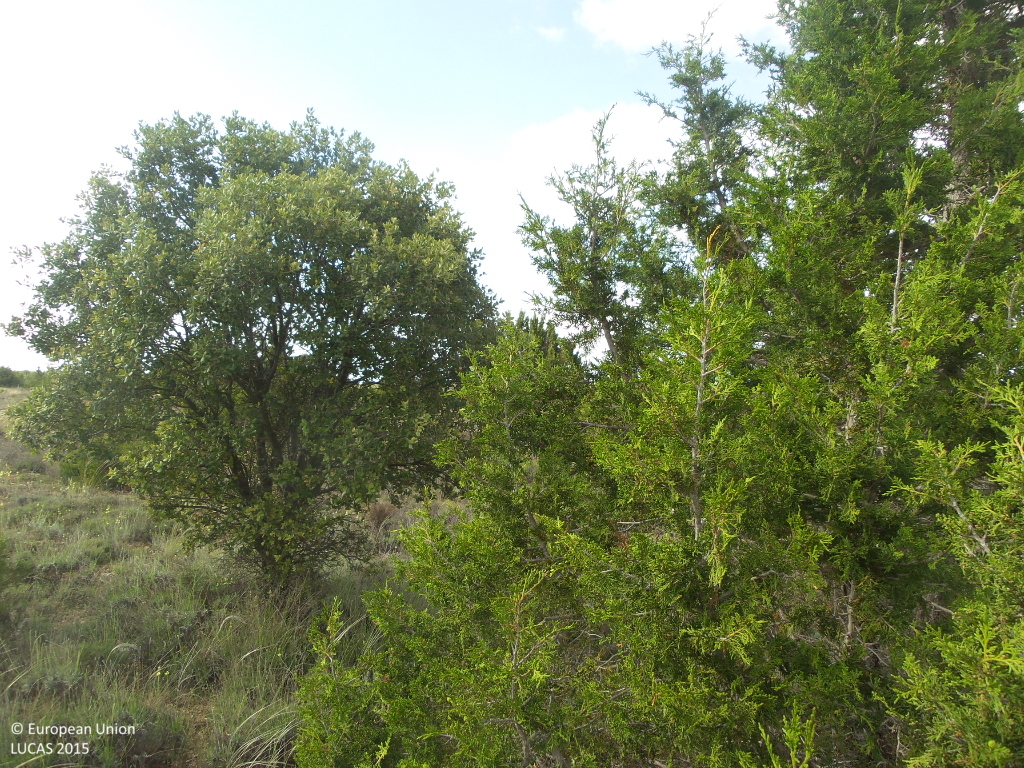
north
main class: Shrubland
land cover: Shrubland with sparse tree cover
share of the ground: 50 - 75 %
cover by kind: shrubs 75 %, herbaceous plants 10 %, unconsolidated bare surface 10 %, coniferous forest trees 5 %
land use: Semi-natural and natural areas not in use
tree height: < 5 m
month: June
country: ES
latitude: 41.3889
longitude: -3.1614
